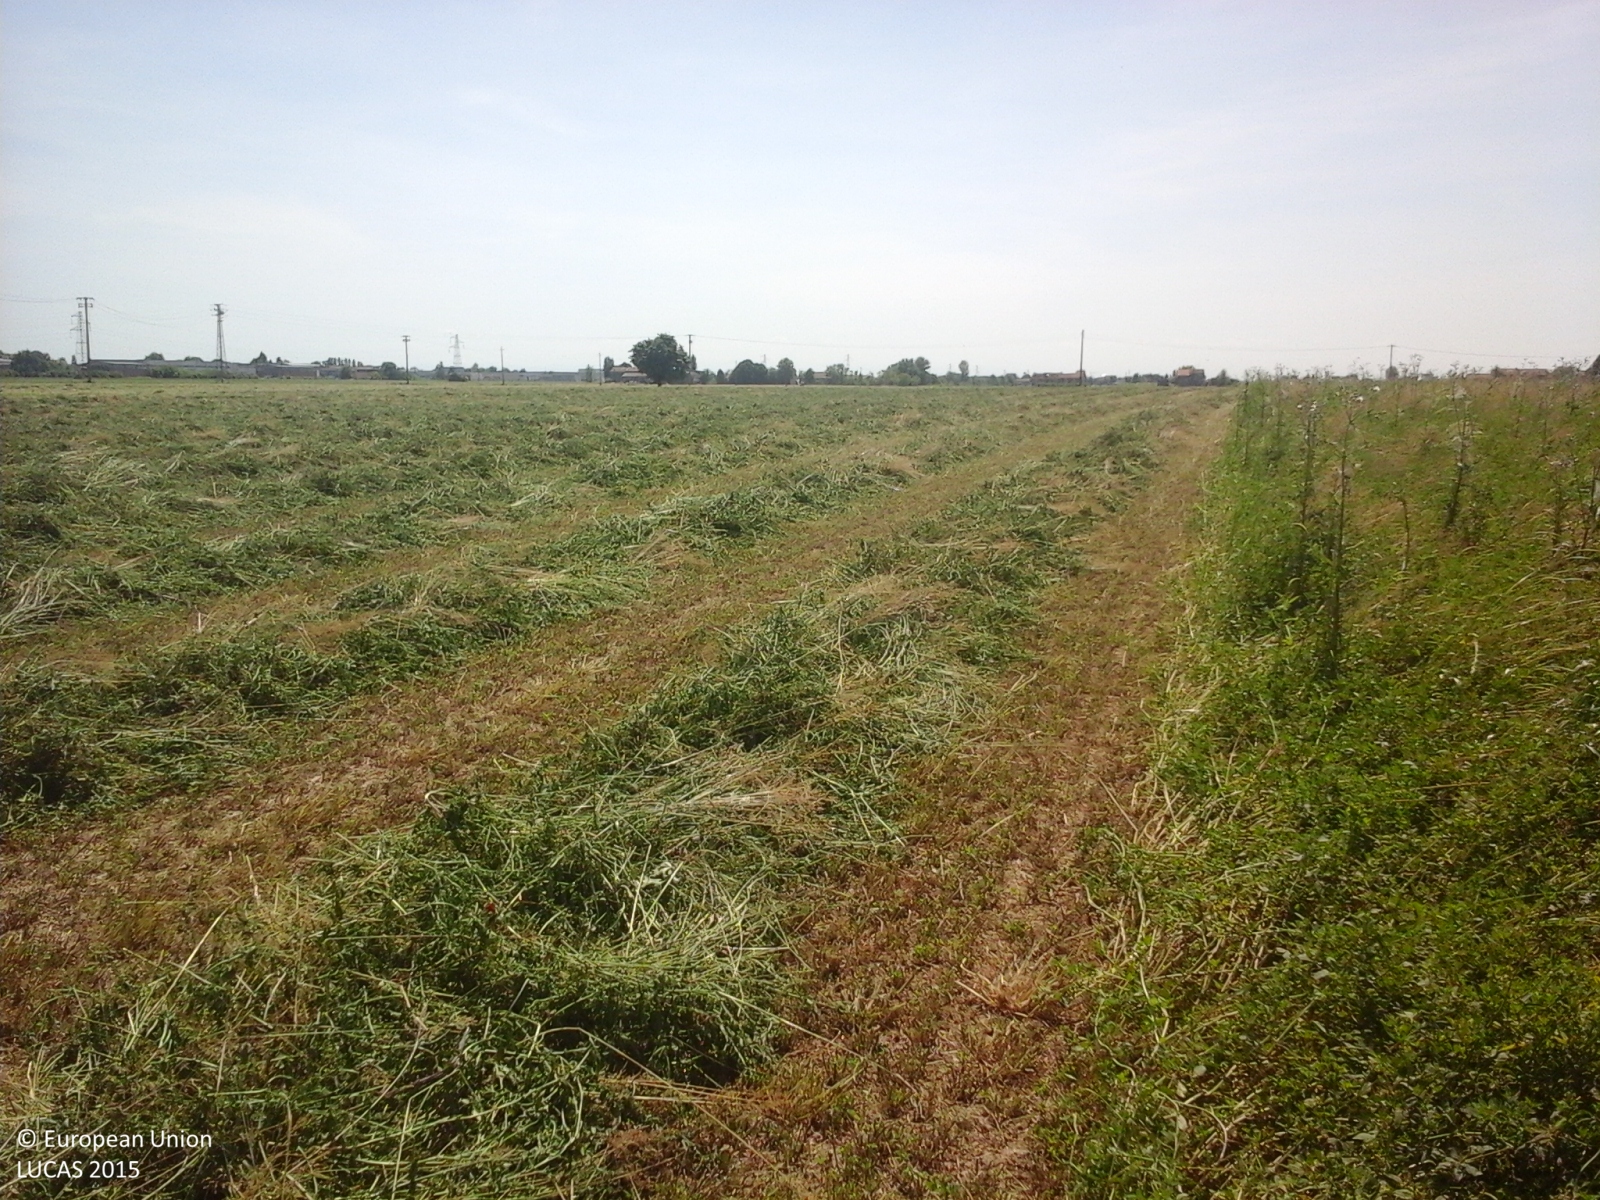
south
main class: Cropland
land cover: Lucerne
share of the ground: > 75 %
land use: Agriculture (excluding fallow land and kitchen gardens)
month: May
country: IT
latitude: 44.9759
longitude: 11.1011
